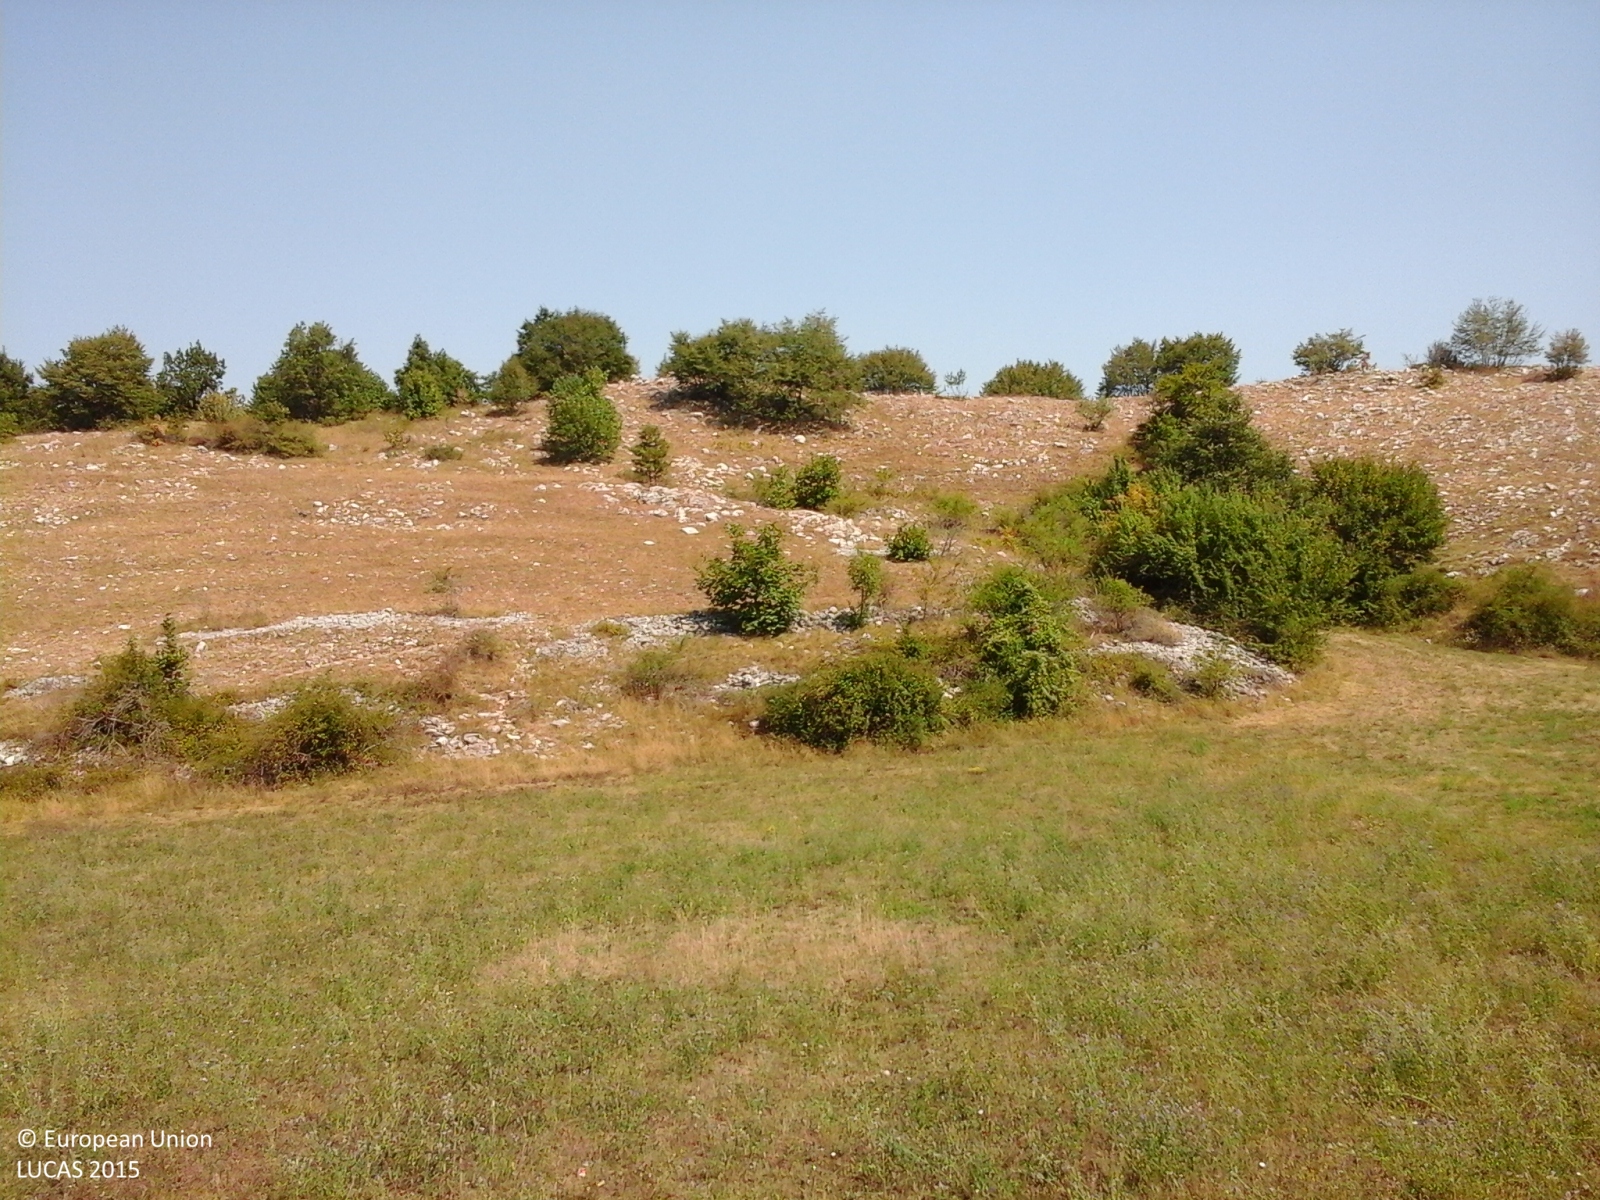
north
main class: Woodland
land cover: Broadleaved woodland
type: thermophilous deciduous forest
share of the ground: > 75 %
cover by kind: broadleaved forest trees 85 %, shrubs 10 %, herbaceous plants 5 %
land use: Forestry
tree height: > 5 m
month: August
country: IT
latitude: 41.4980
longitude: 14.2371
